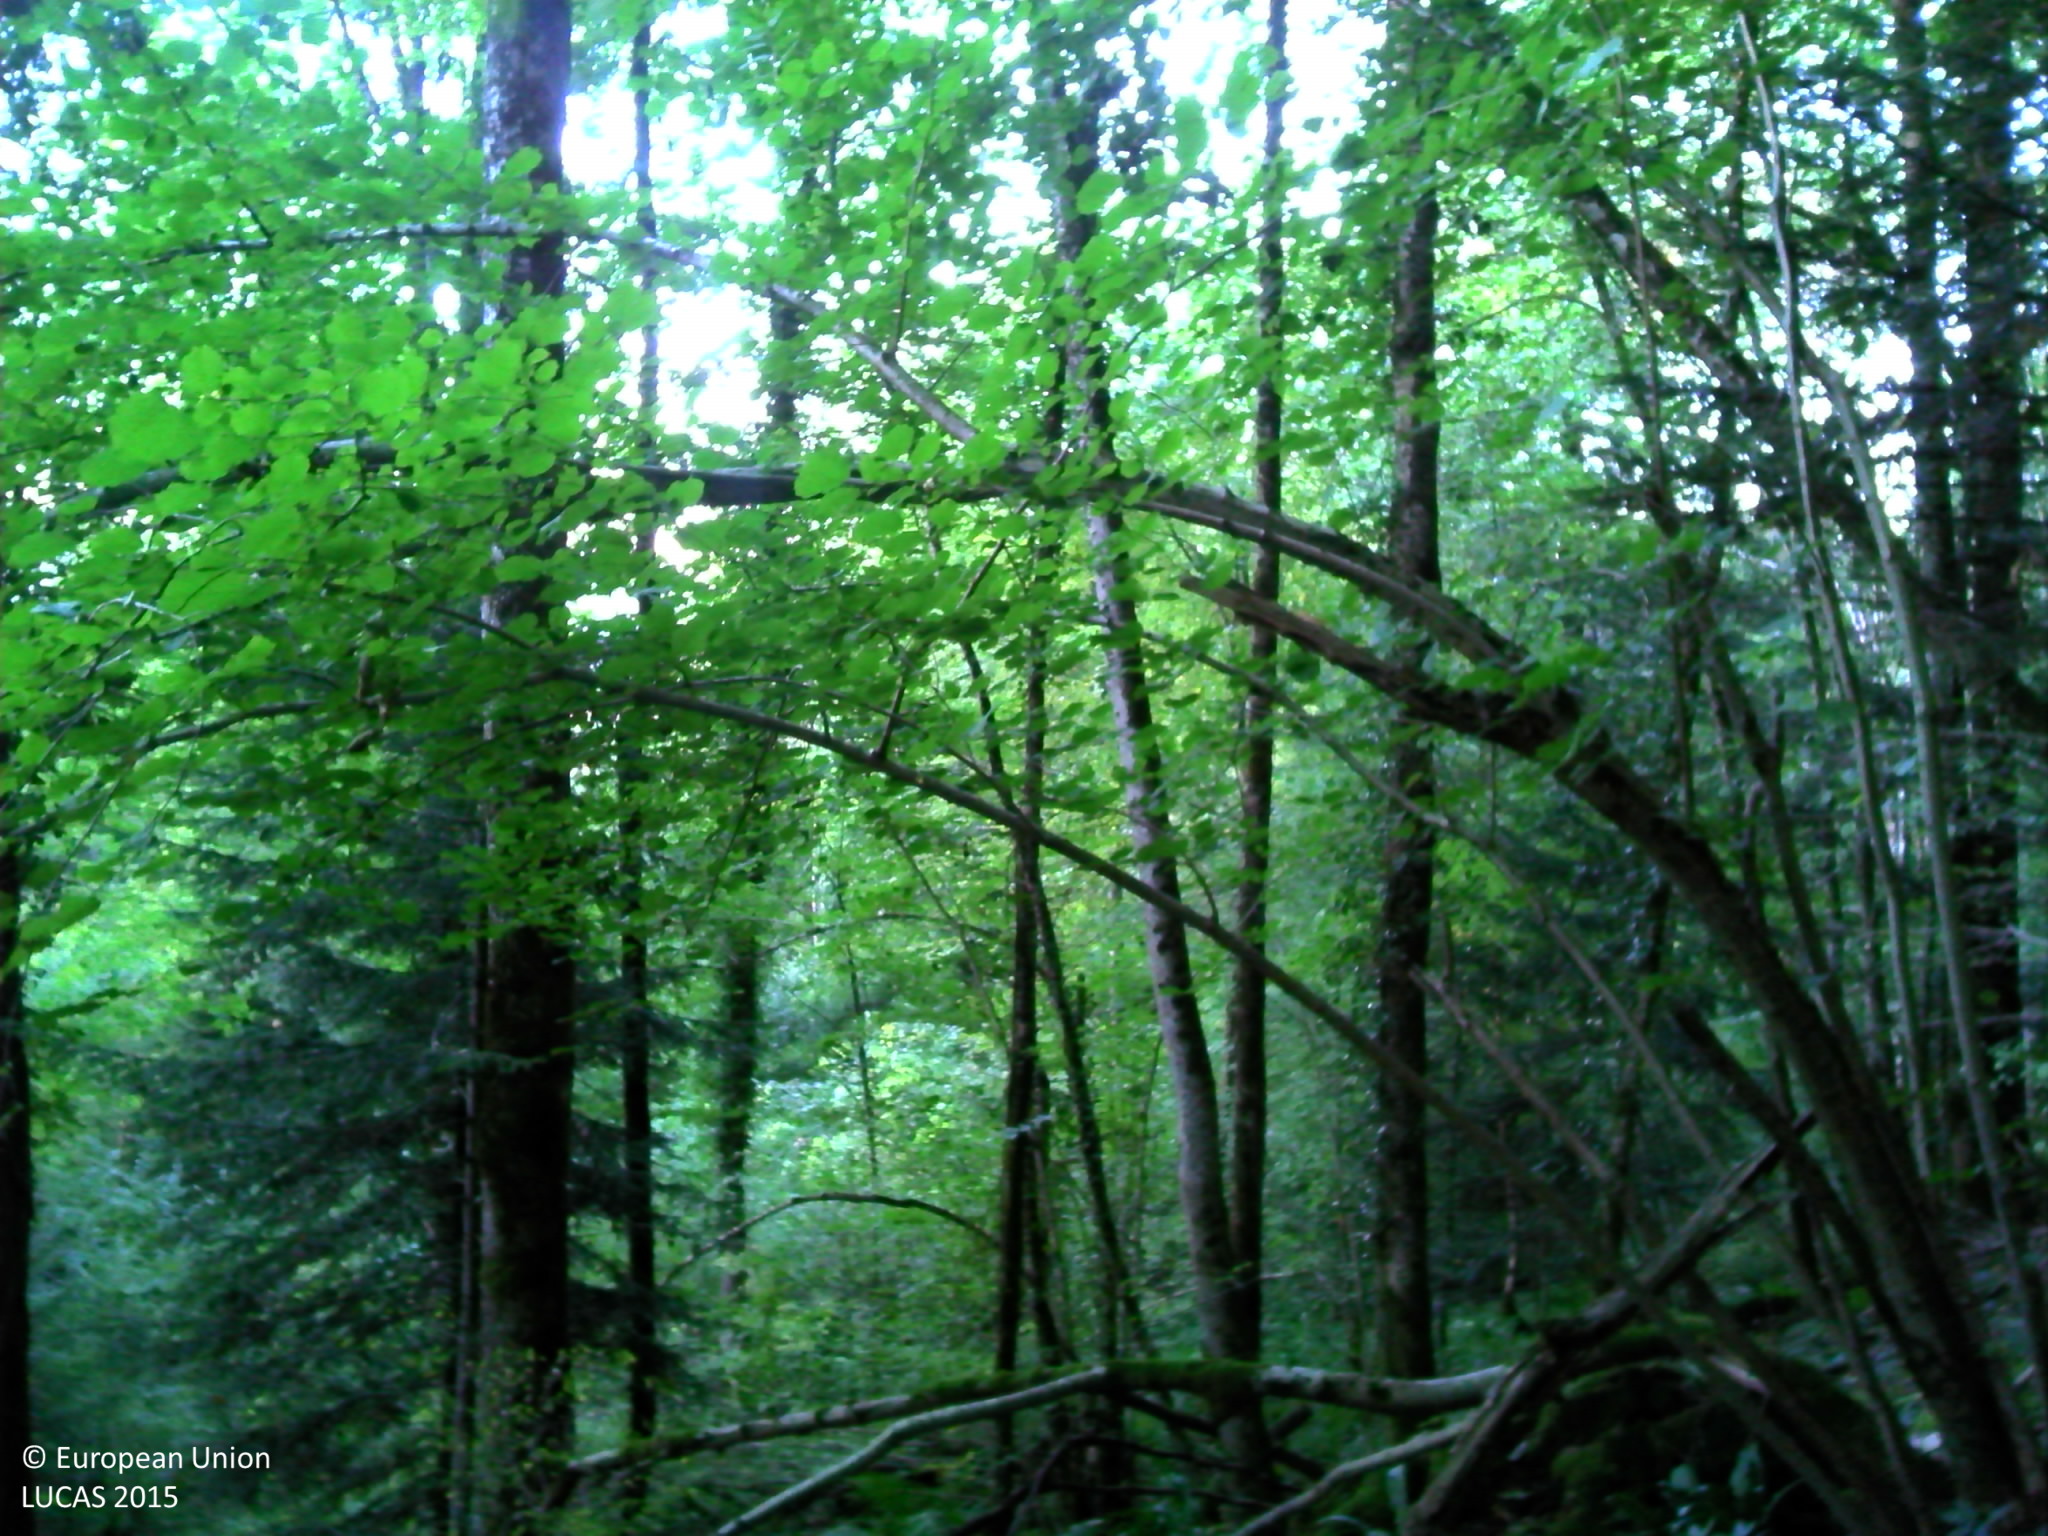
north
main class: Woodland
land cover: Broadleaved woodland
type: mesophytic deciduous forest
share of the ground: > 75 %
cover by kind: broadleaved forest trees 90 %, shrubs 5 %, herbaceous plants 5 %
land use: Forestry
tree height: > 5 m
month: September
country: FR
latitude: 47.3145
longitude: 6.8667
